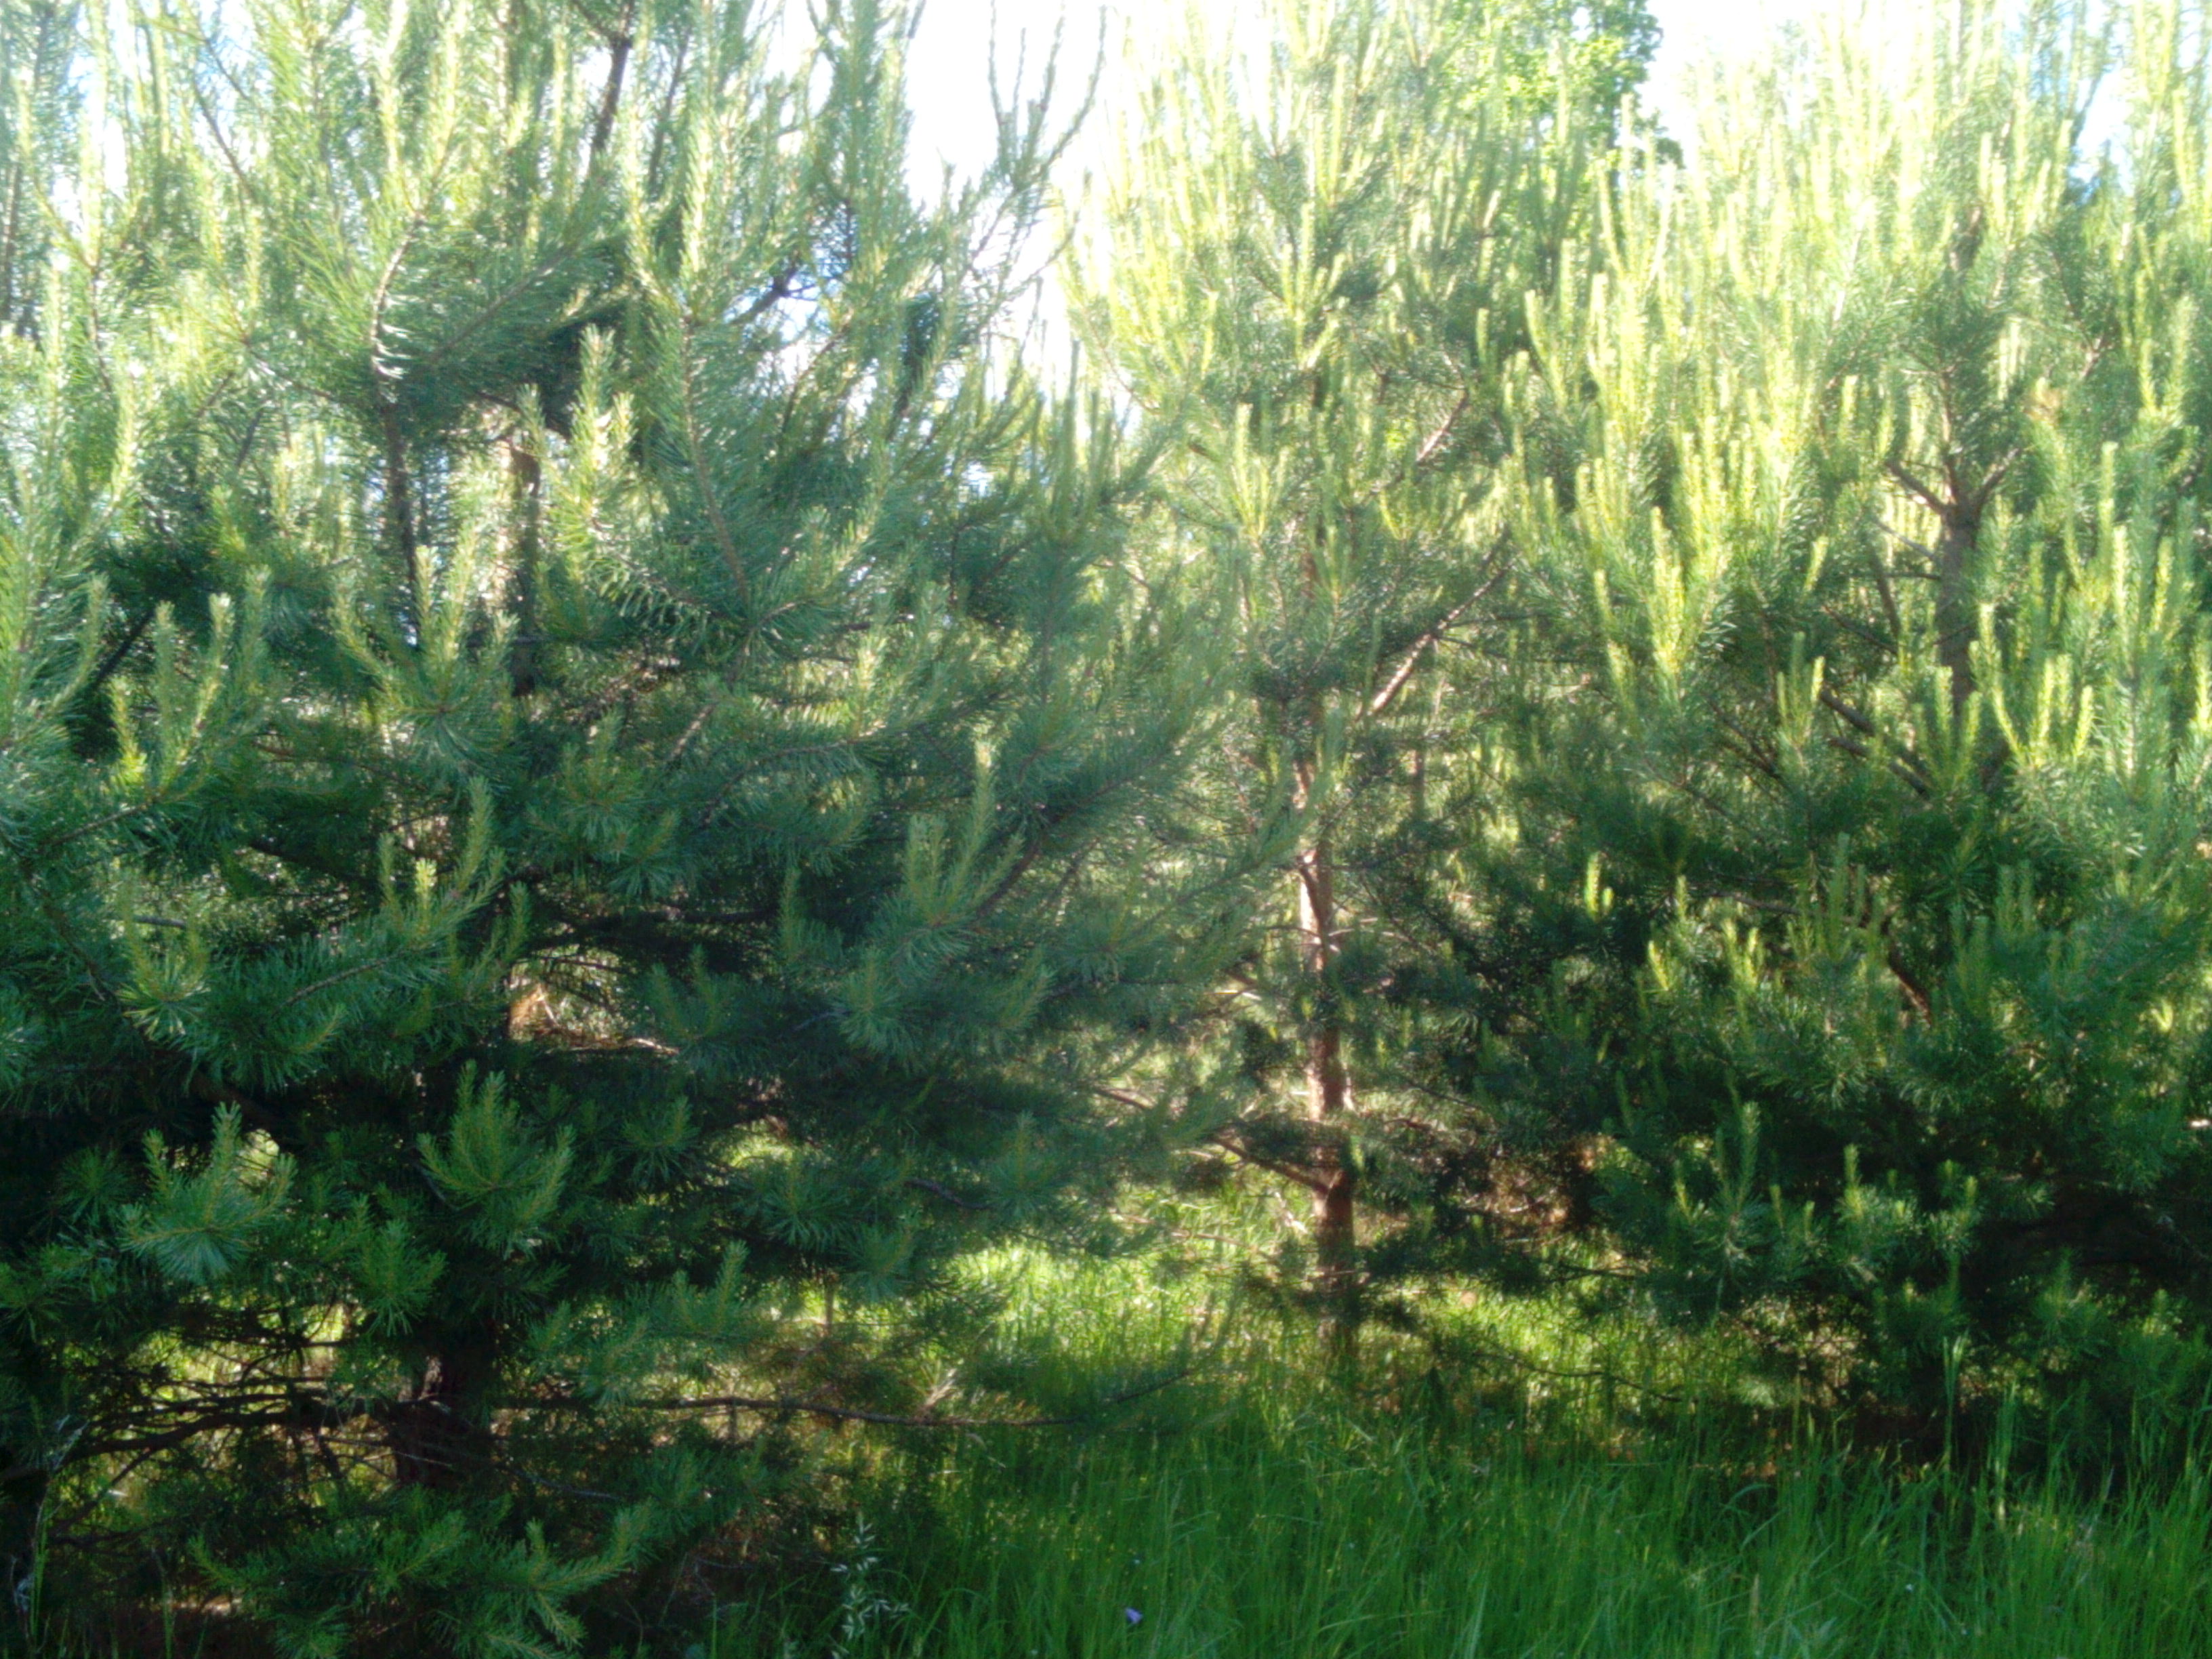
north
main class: Woodland
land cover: Pine dominated coniferous woodland
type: hemiboreal forest and nemoral coniferous forest and mixed broadleaved-coniferous forest
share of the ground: 50 - 75 %
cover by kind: coniferous forest trees 50 %, herbaceous plants 50 %
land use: Forestry
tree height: < 5 m
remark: Nursery
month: June
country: LV
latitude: 56.7208
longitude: 22.1260
